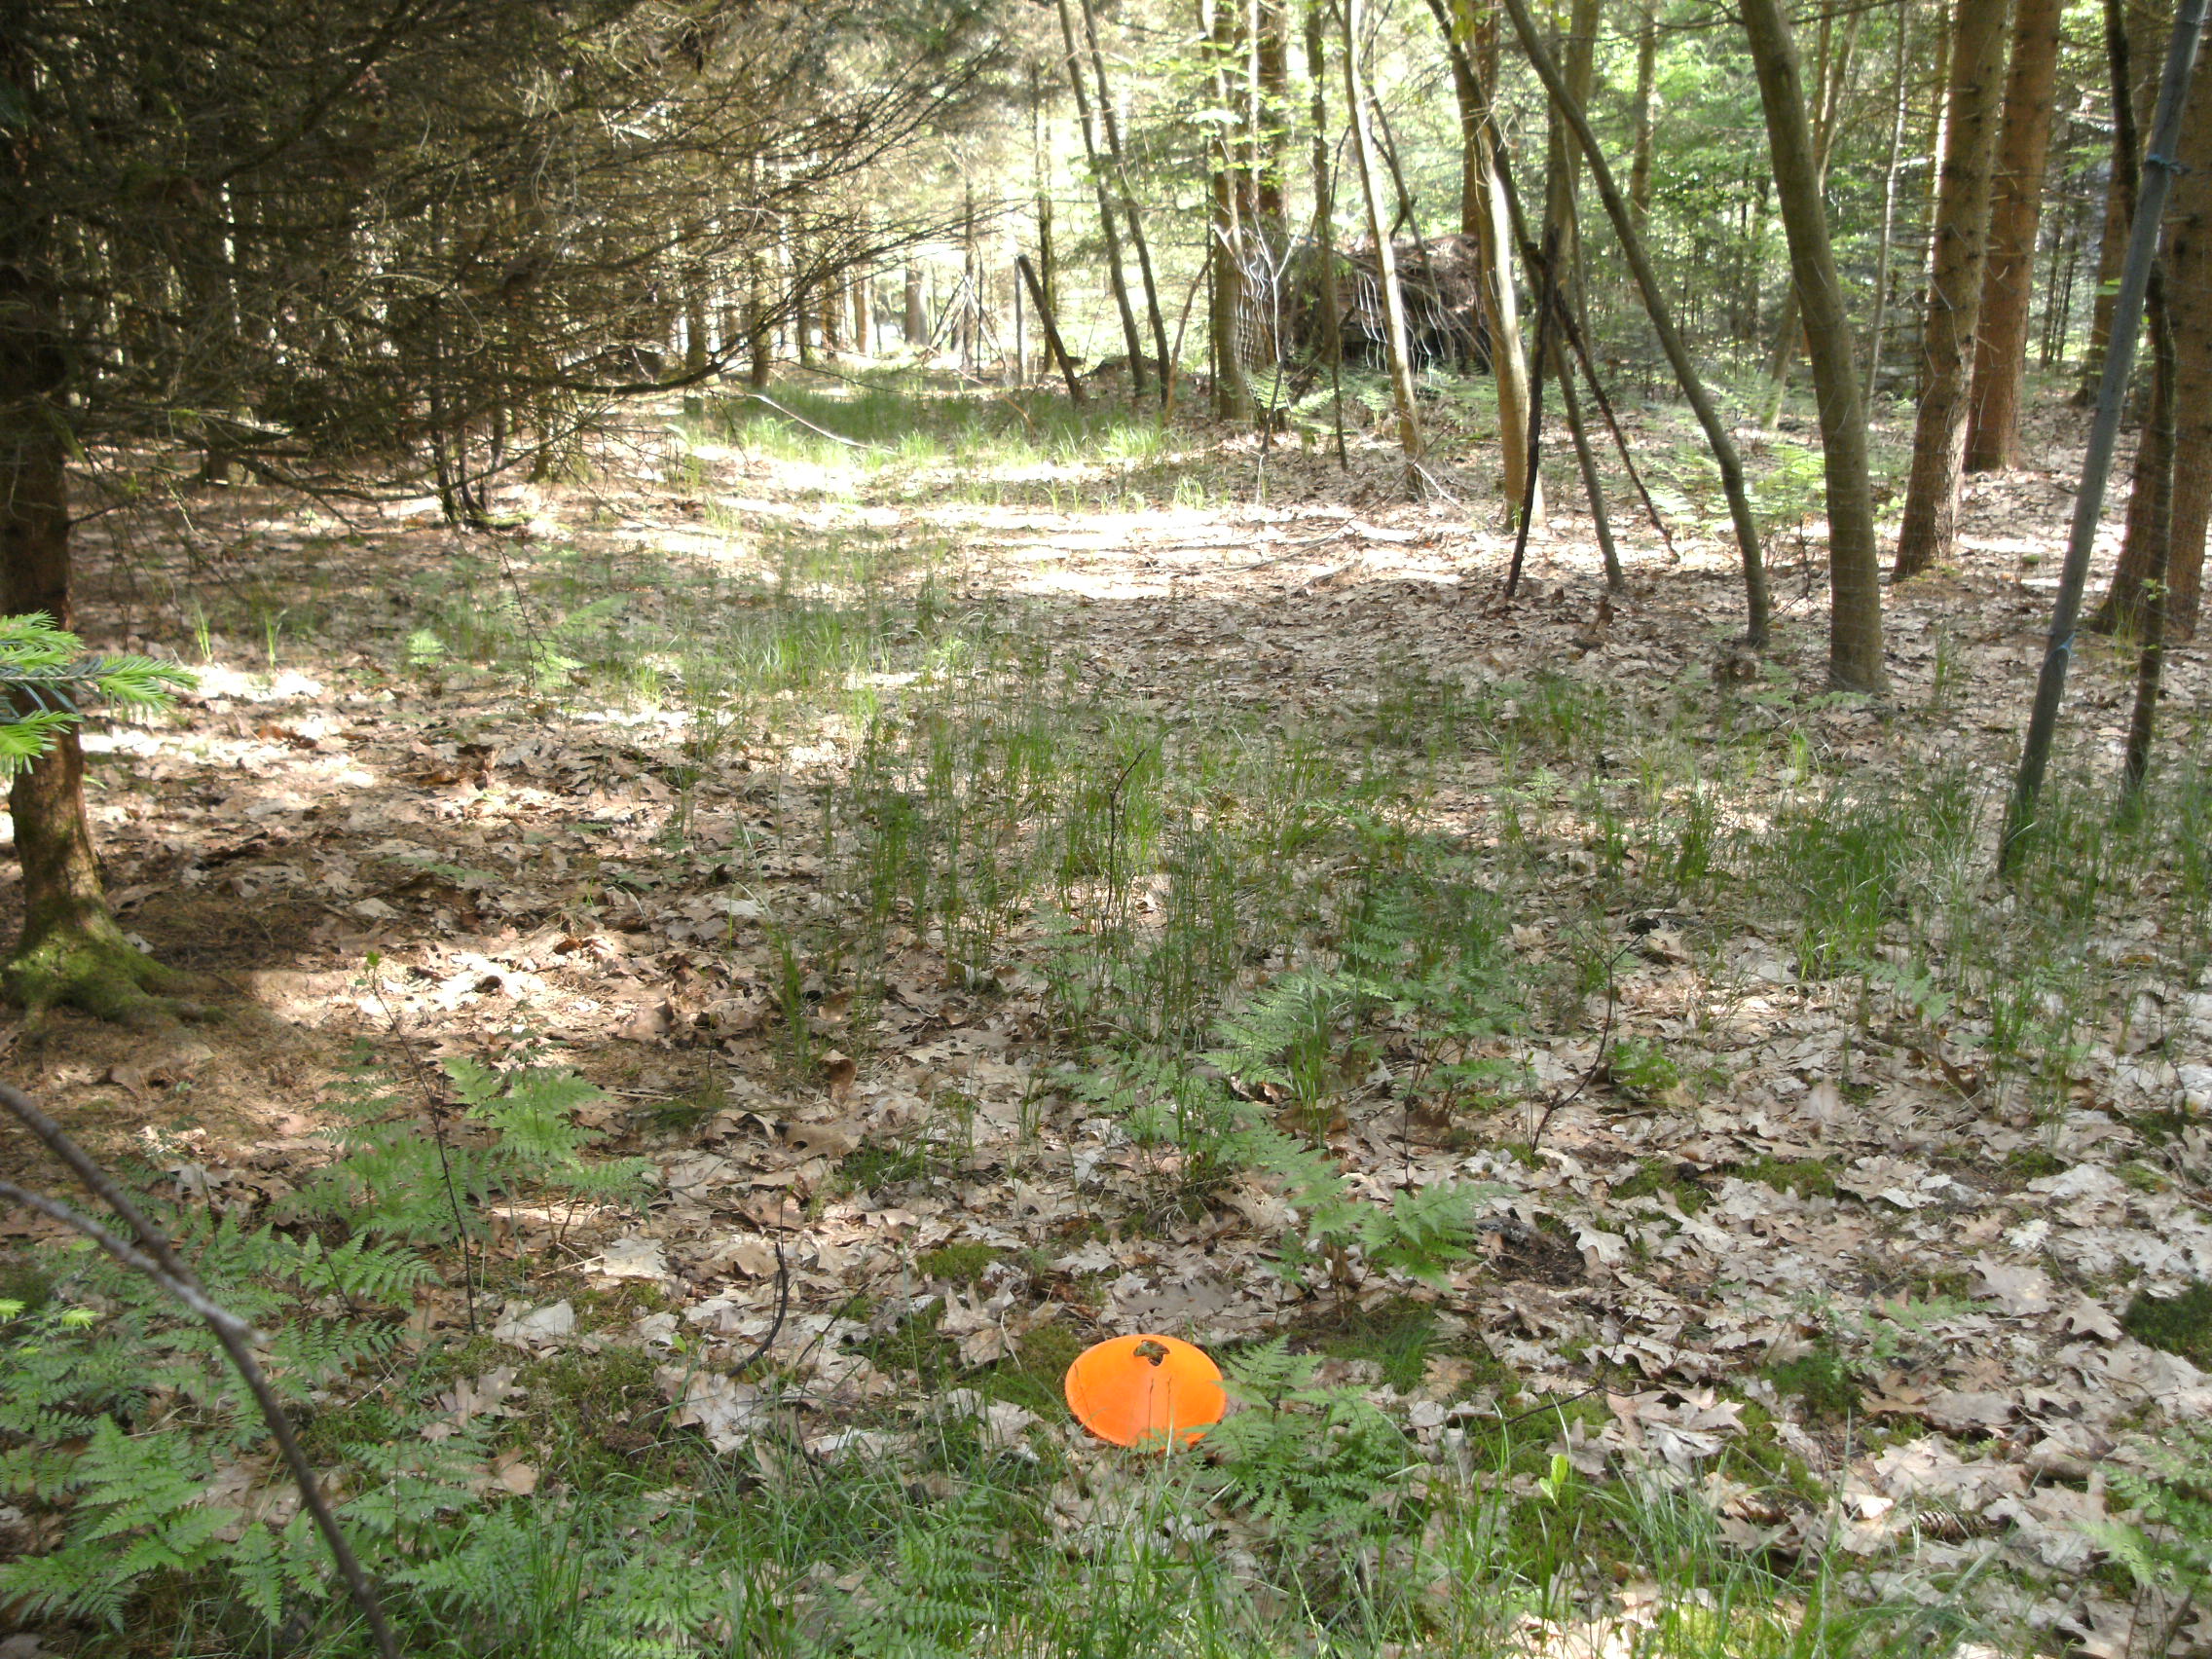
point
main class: Woodland
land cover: Spruce dominated mixed woodland
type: hemiboreal forest and nemoral coniferous forest and mixed broadleaved-coniferous forest
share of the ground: > 75 %
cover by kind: coniferous forest trees 50 %, broadleaved forest trees 40 %, herbaceous plants 10 %
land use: Forestry
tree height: > 5 m
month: May
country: AT
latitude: 48.4912
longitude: 13.5312
